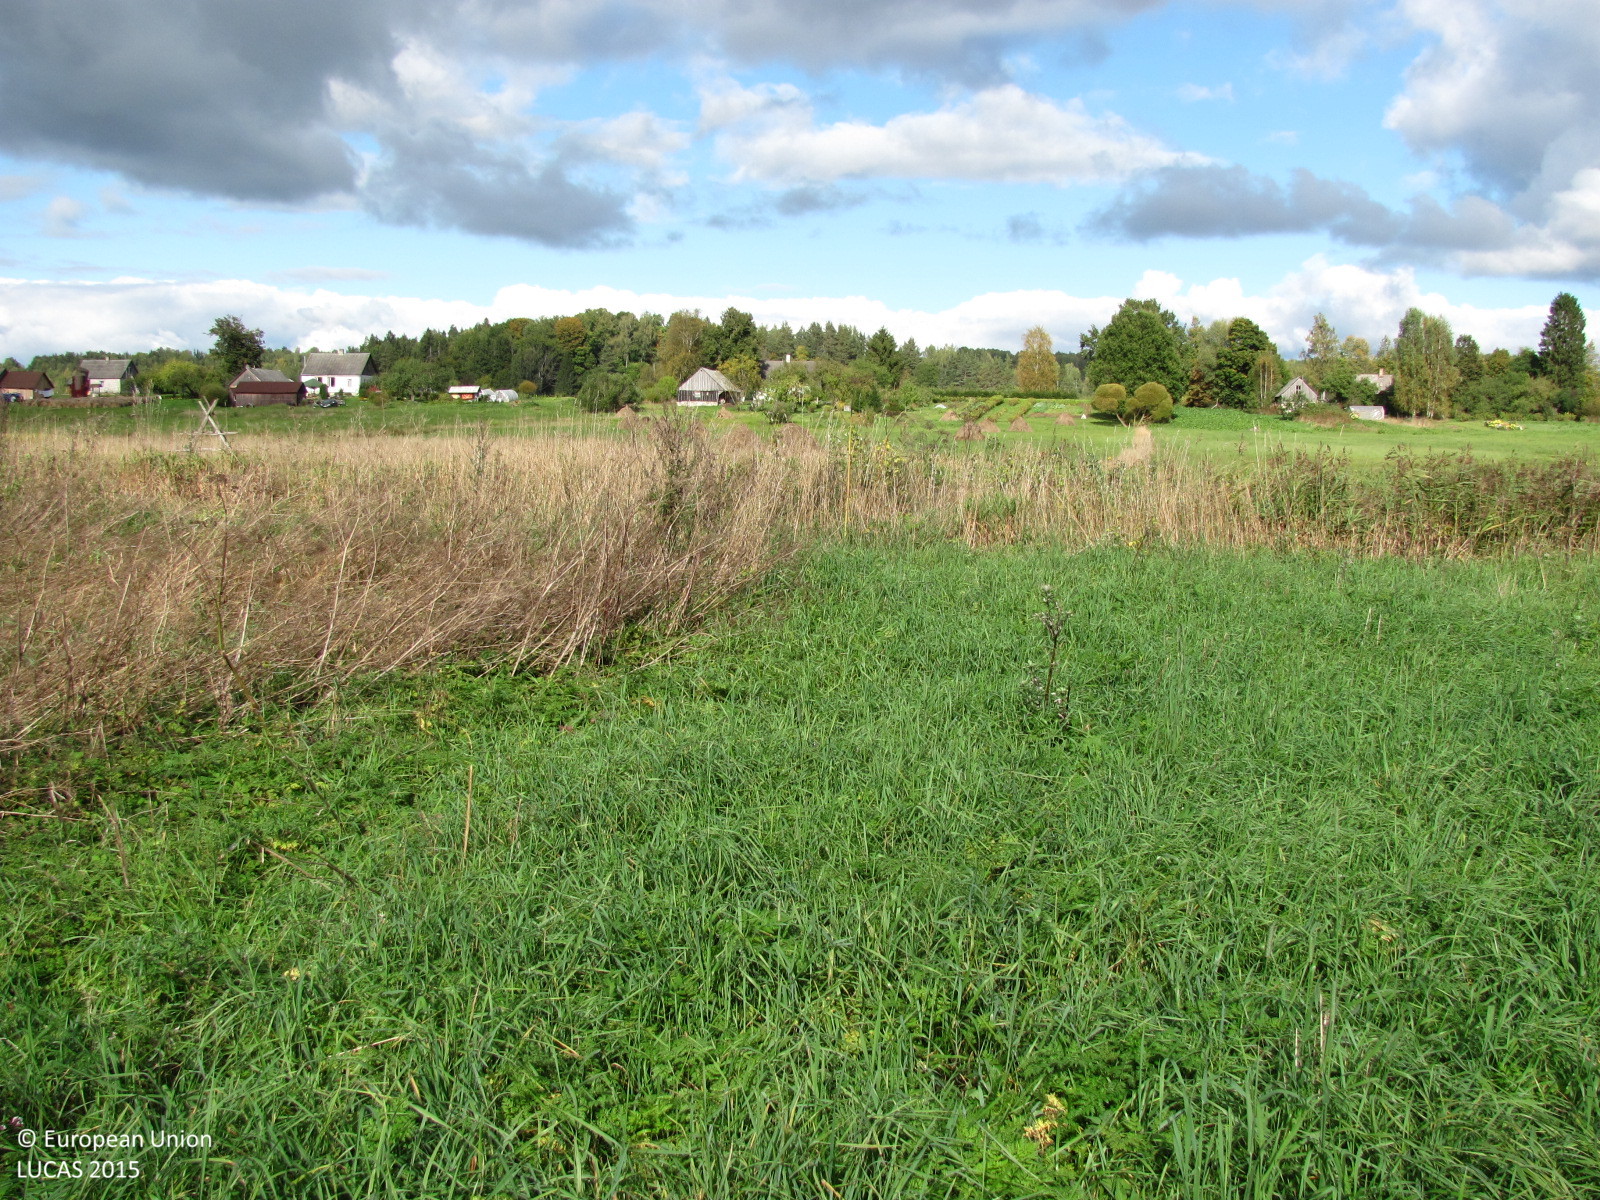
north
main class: Grassland
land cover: Grassland without tree/shrub cover
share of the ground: > 75 %
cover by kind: herbaceous plants 100 %
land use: Agriculture (excluding fallow land and kitchen gardens)
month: September
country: LV
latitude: 56.8328
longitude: 25.2056
